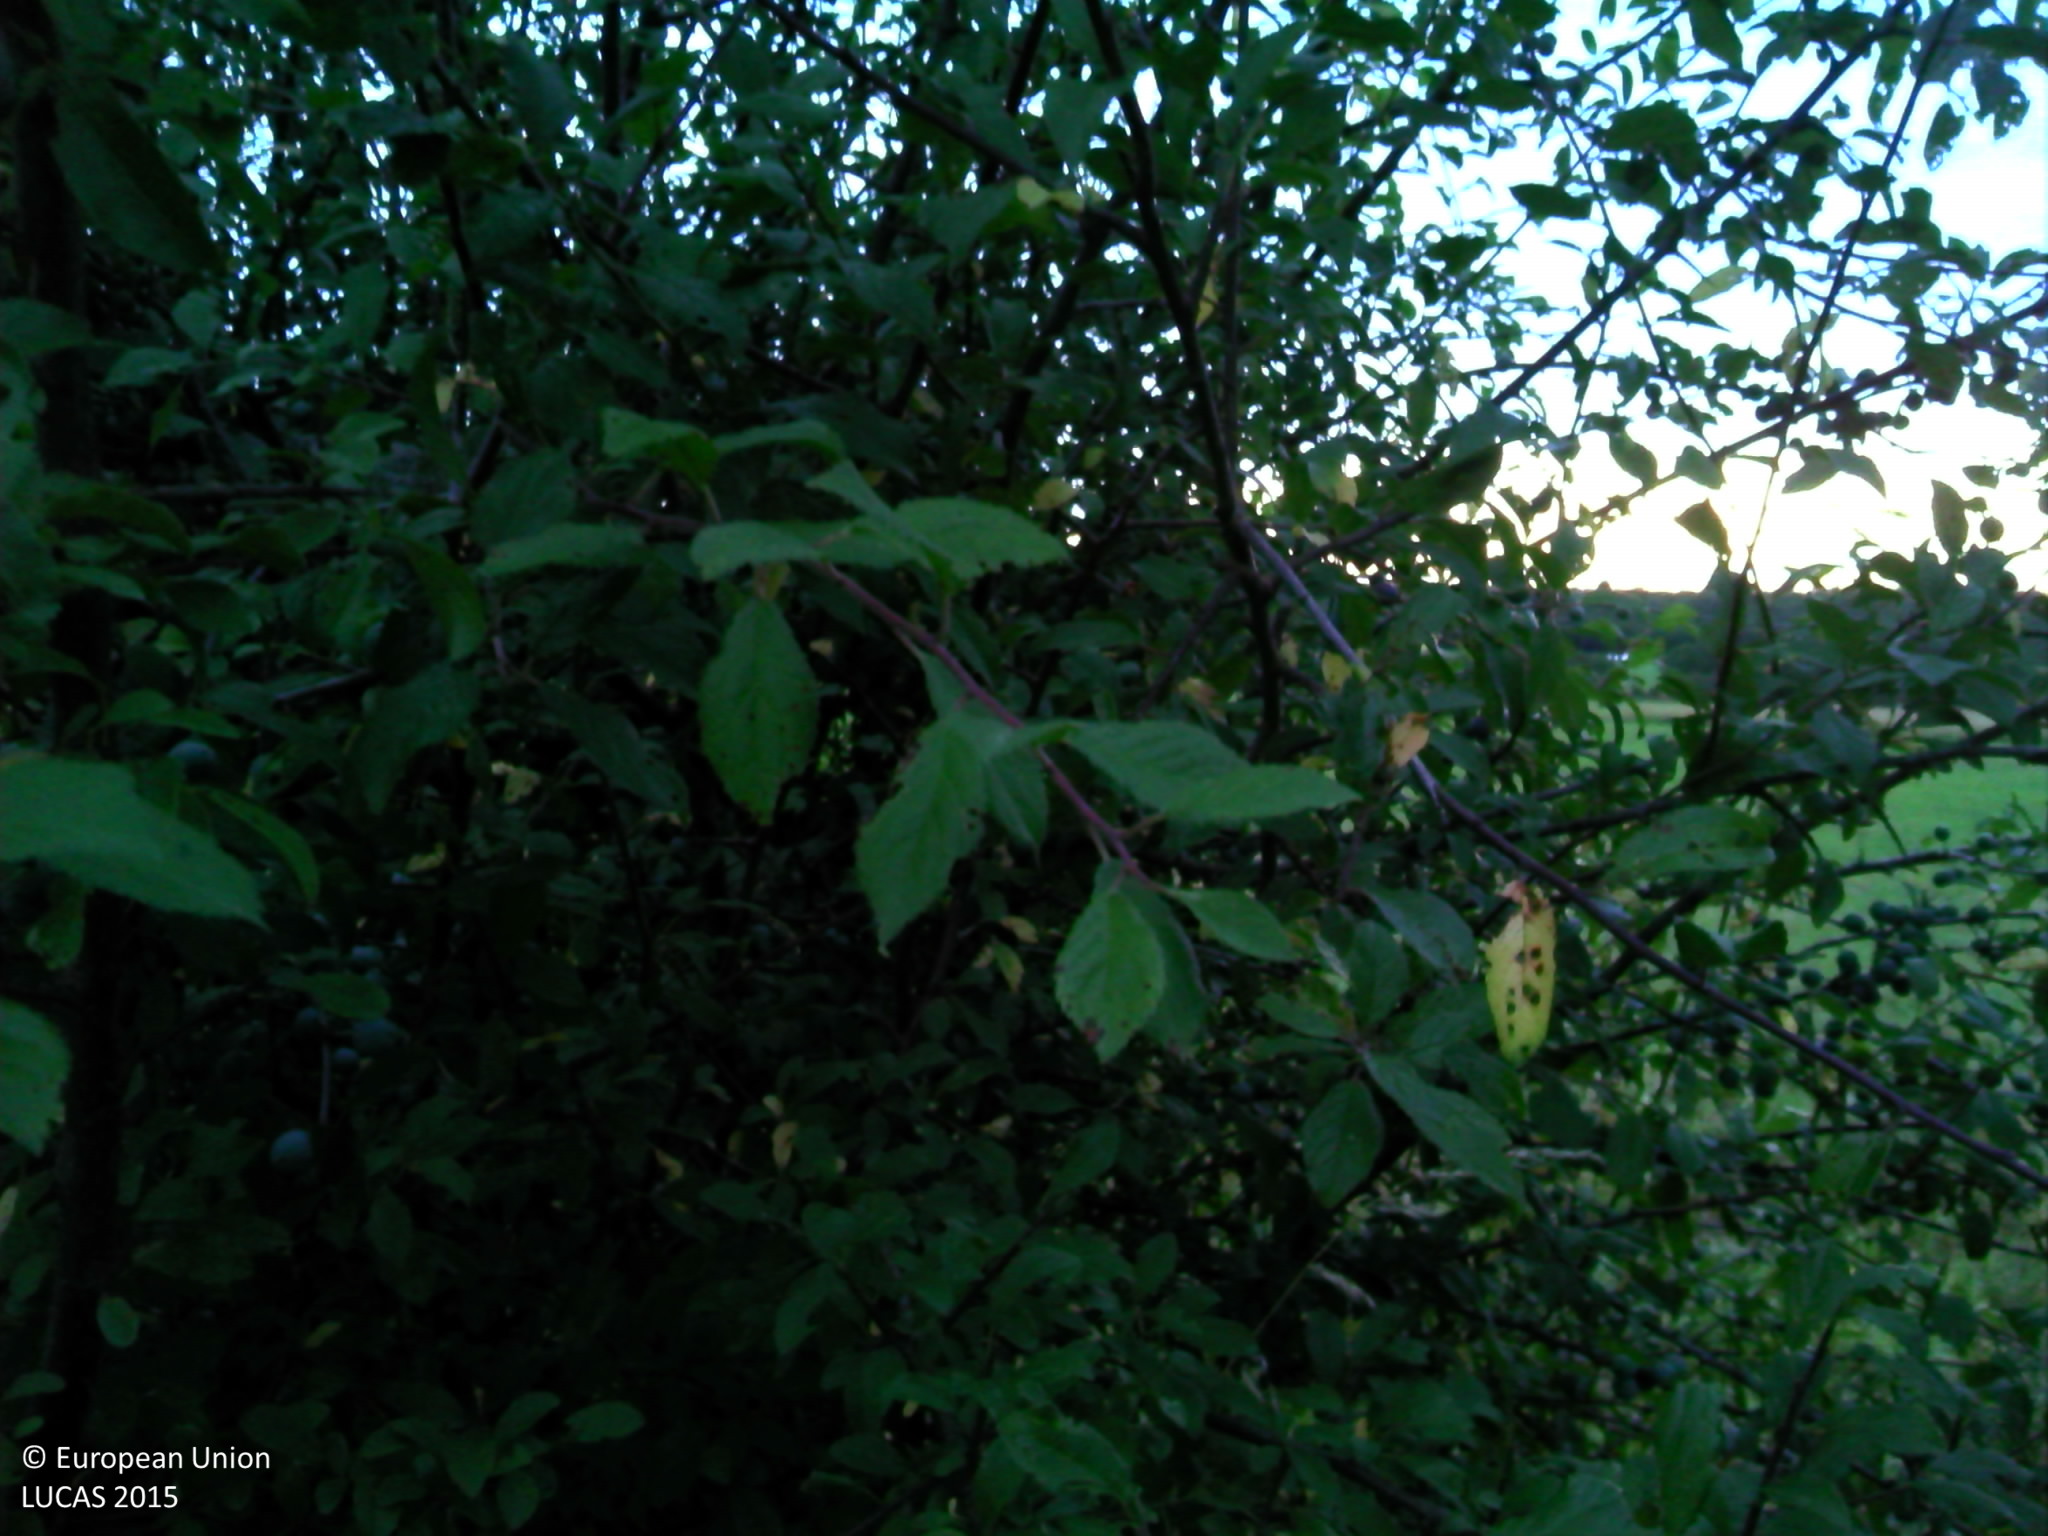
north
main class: Grassland
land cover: Grassland without tree/shrub cover
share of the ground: > 75 %
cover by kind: herbaceous plants 100 %
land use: Agriculture (excluding fallow land and kitchen gardens)
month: July
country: BE
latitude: 49.7124
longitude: 5.3801
